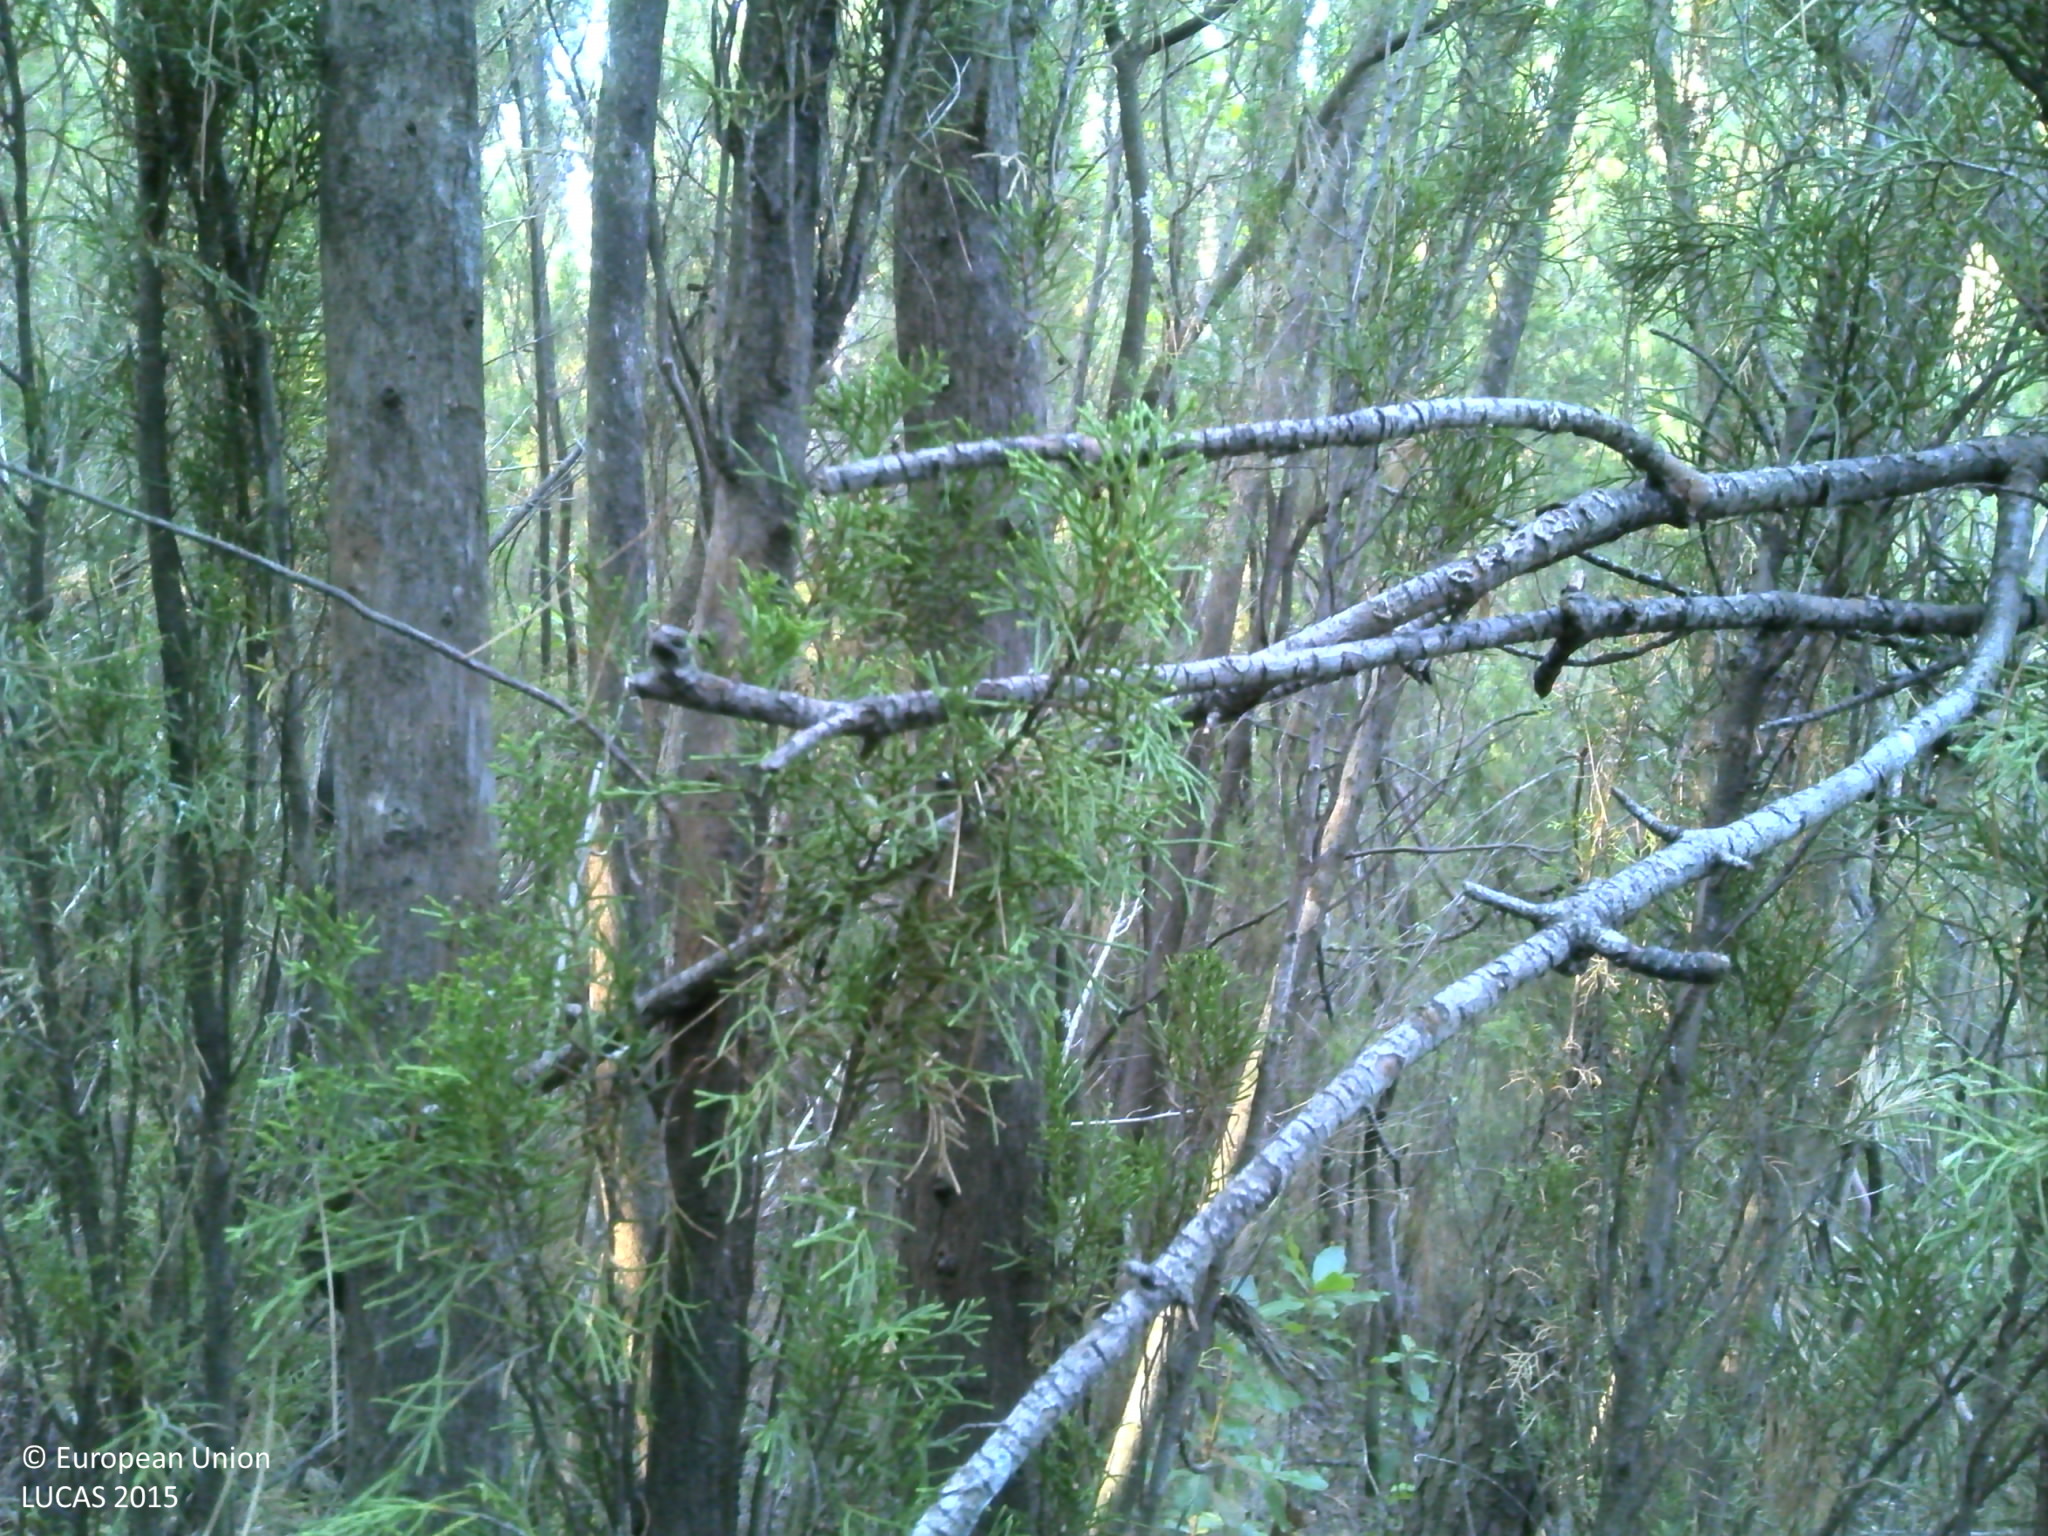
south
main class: Woodland
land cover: Other coniferous woodland
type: coniferous forest of the mediterranean region
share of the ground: > 75 %
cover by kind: coniferous forest trees 80 %, herbaceous plants 10 %, shrubs 5 %, consolidated bare surface 5 %
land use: Semi-natural and natural areas not in use
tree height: > 5 m
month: July
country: HR
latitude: 42.5222
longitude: 18.4019
